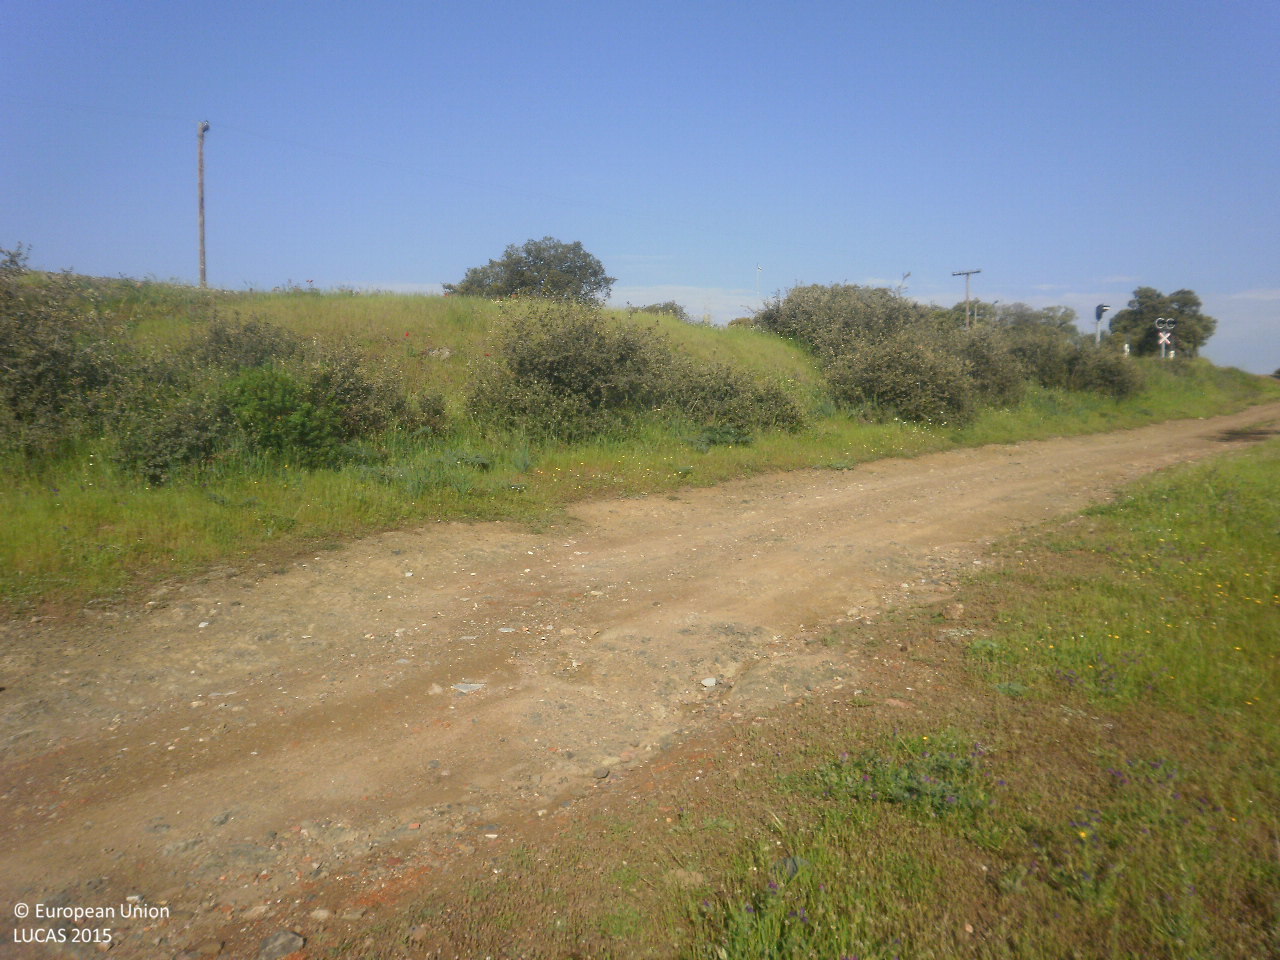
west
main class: Grassland
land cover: Grassland with sparse tree/shrub cover
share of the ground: > 75 %
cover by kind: herbaceous plants 95 %, broadleaved forest trees 5 %
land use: Agriculture (excluding fallow land and kitchen gardens)
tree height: > 5 m
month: April
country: ES
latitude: 38.7287
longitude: -5.1834
